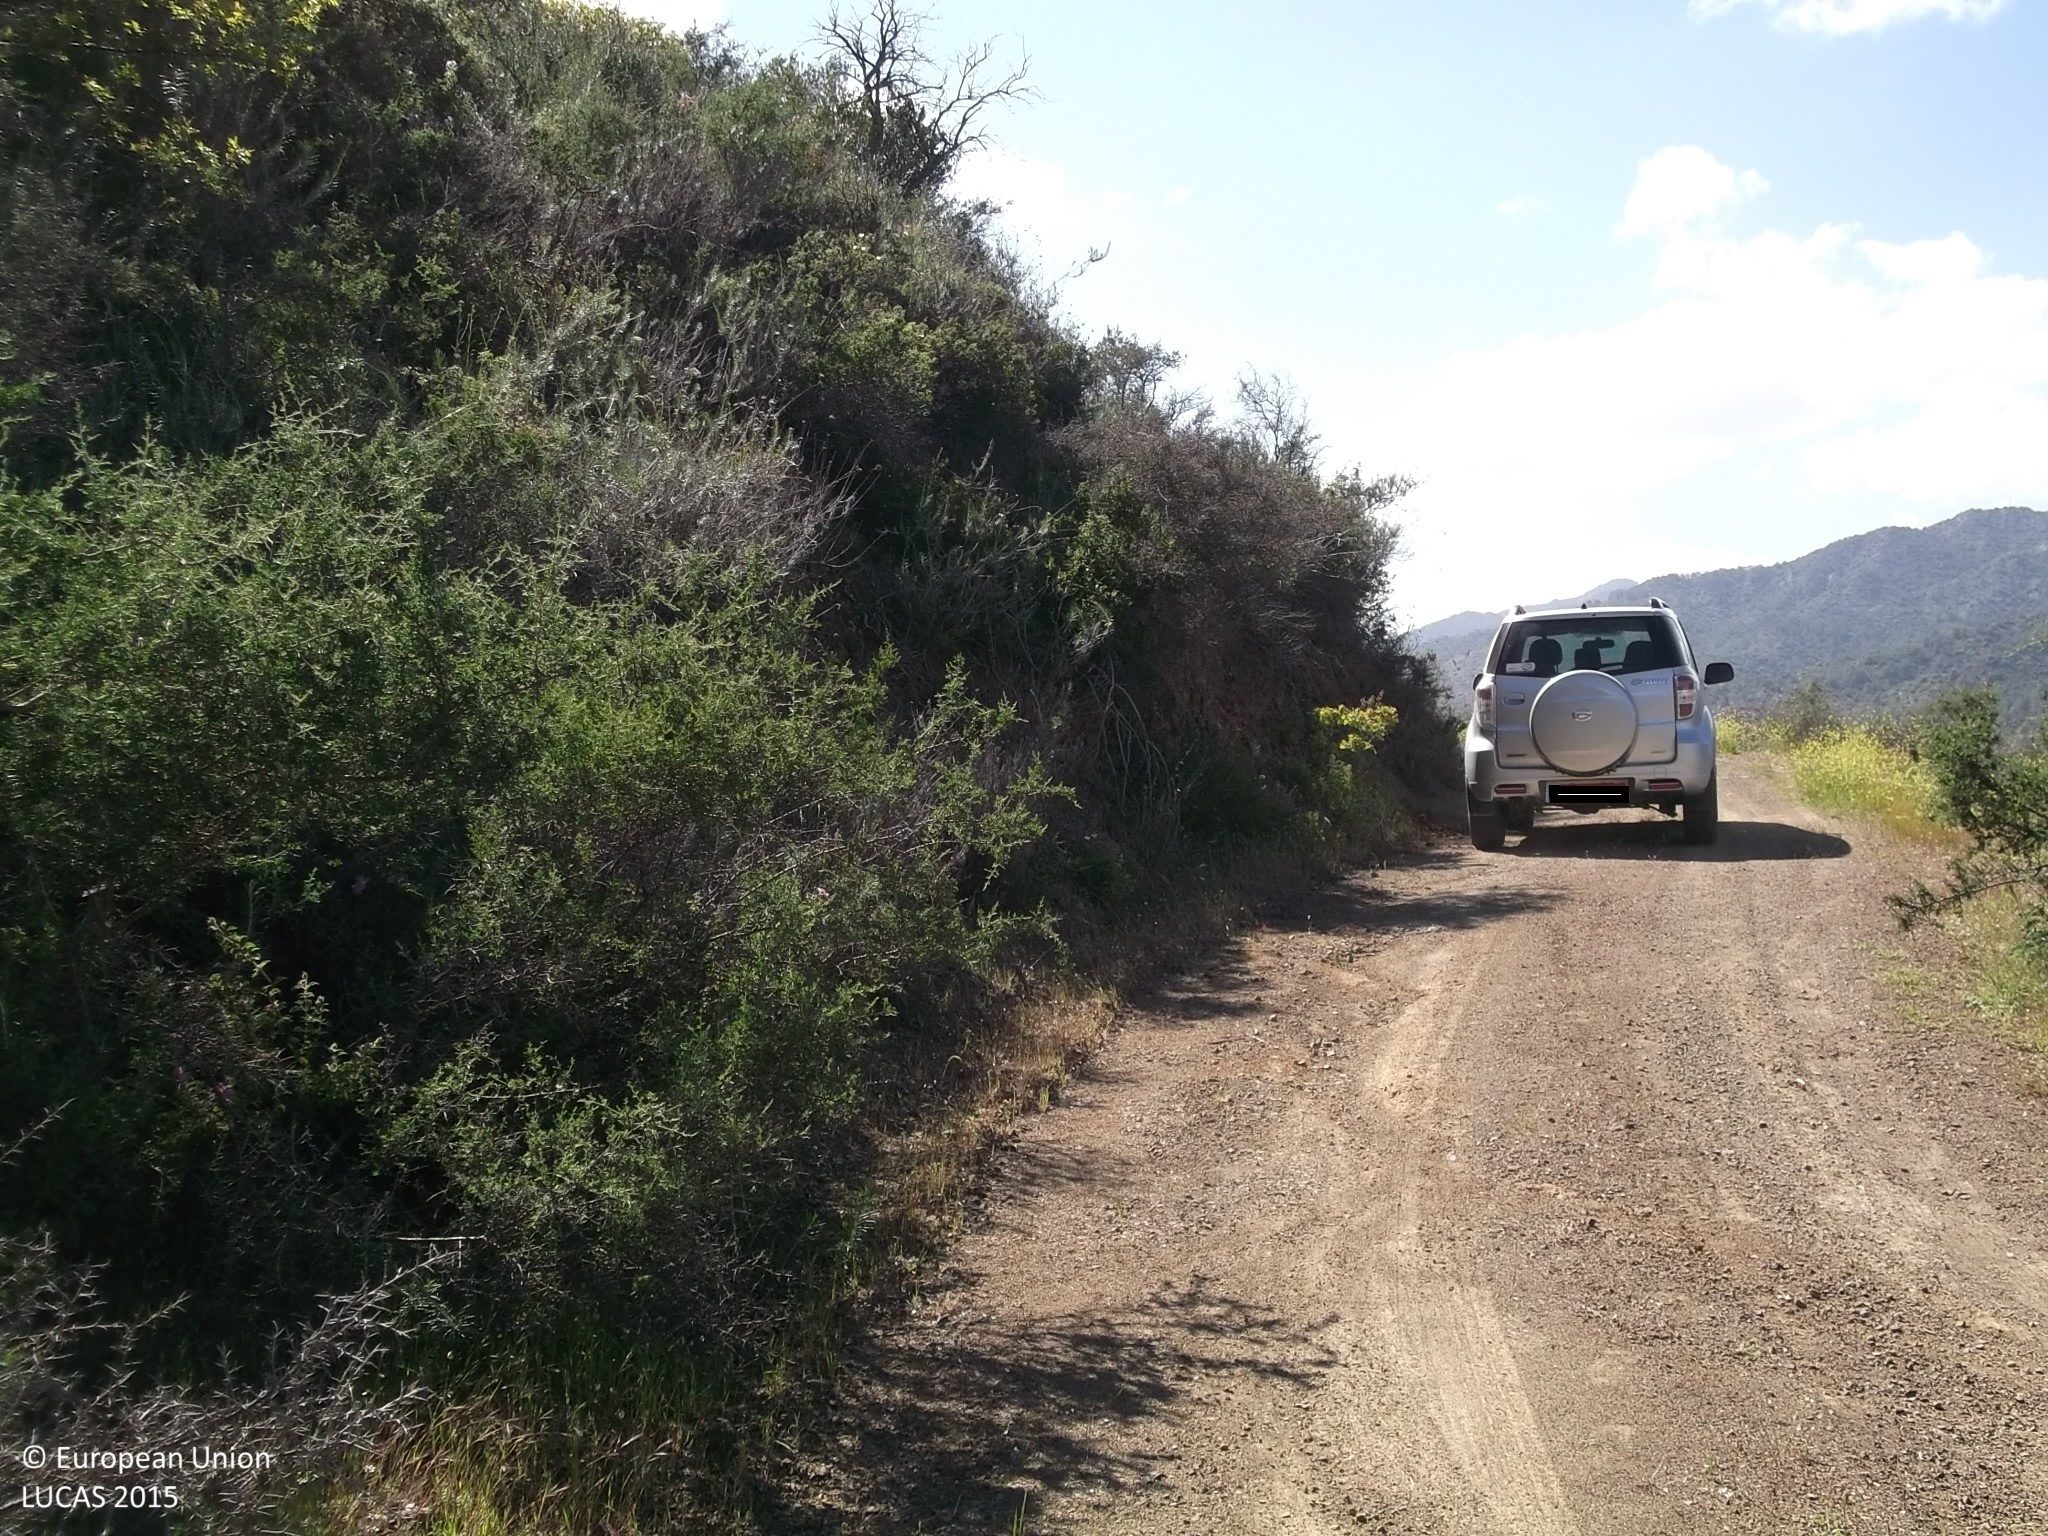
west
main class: Shrubland
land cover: Shrubland with sparse tree cover
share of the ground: > 75 %
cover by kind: shrubs 85 %, unconsolidated bare surface 10 %, coniferous forest trees 5 %
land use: Semi-natural and natural areas not in use
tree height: > 5 m
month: April
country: CY
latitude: 34.8421
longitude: 33.1050
